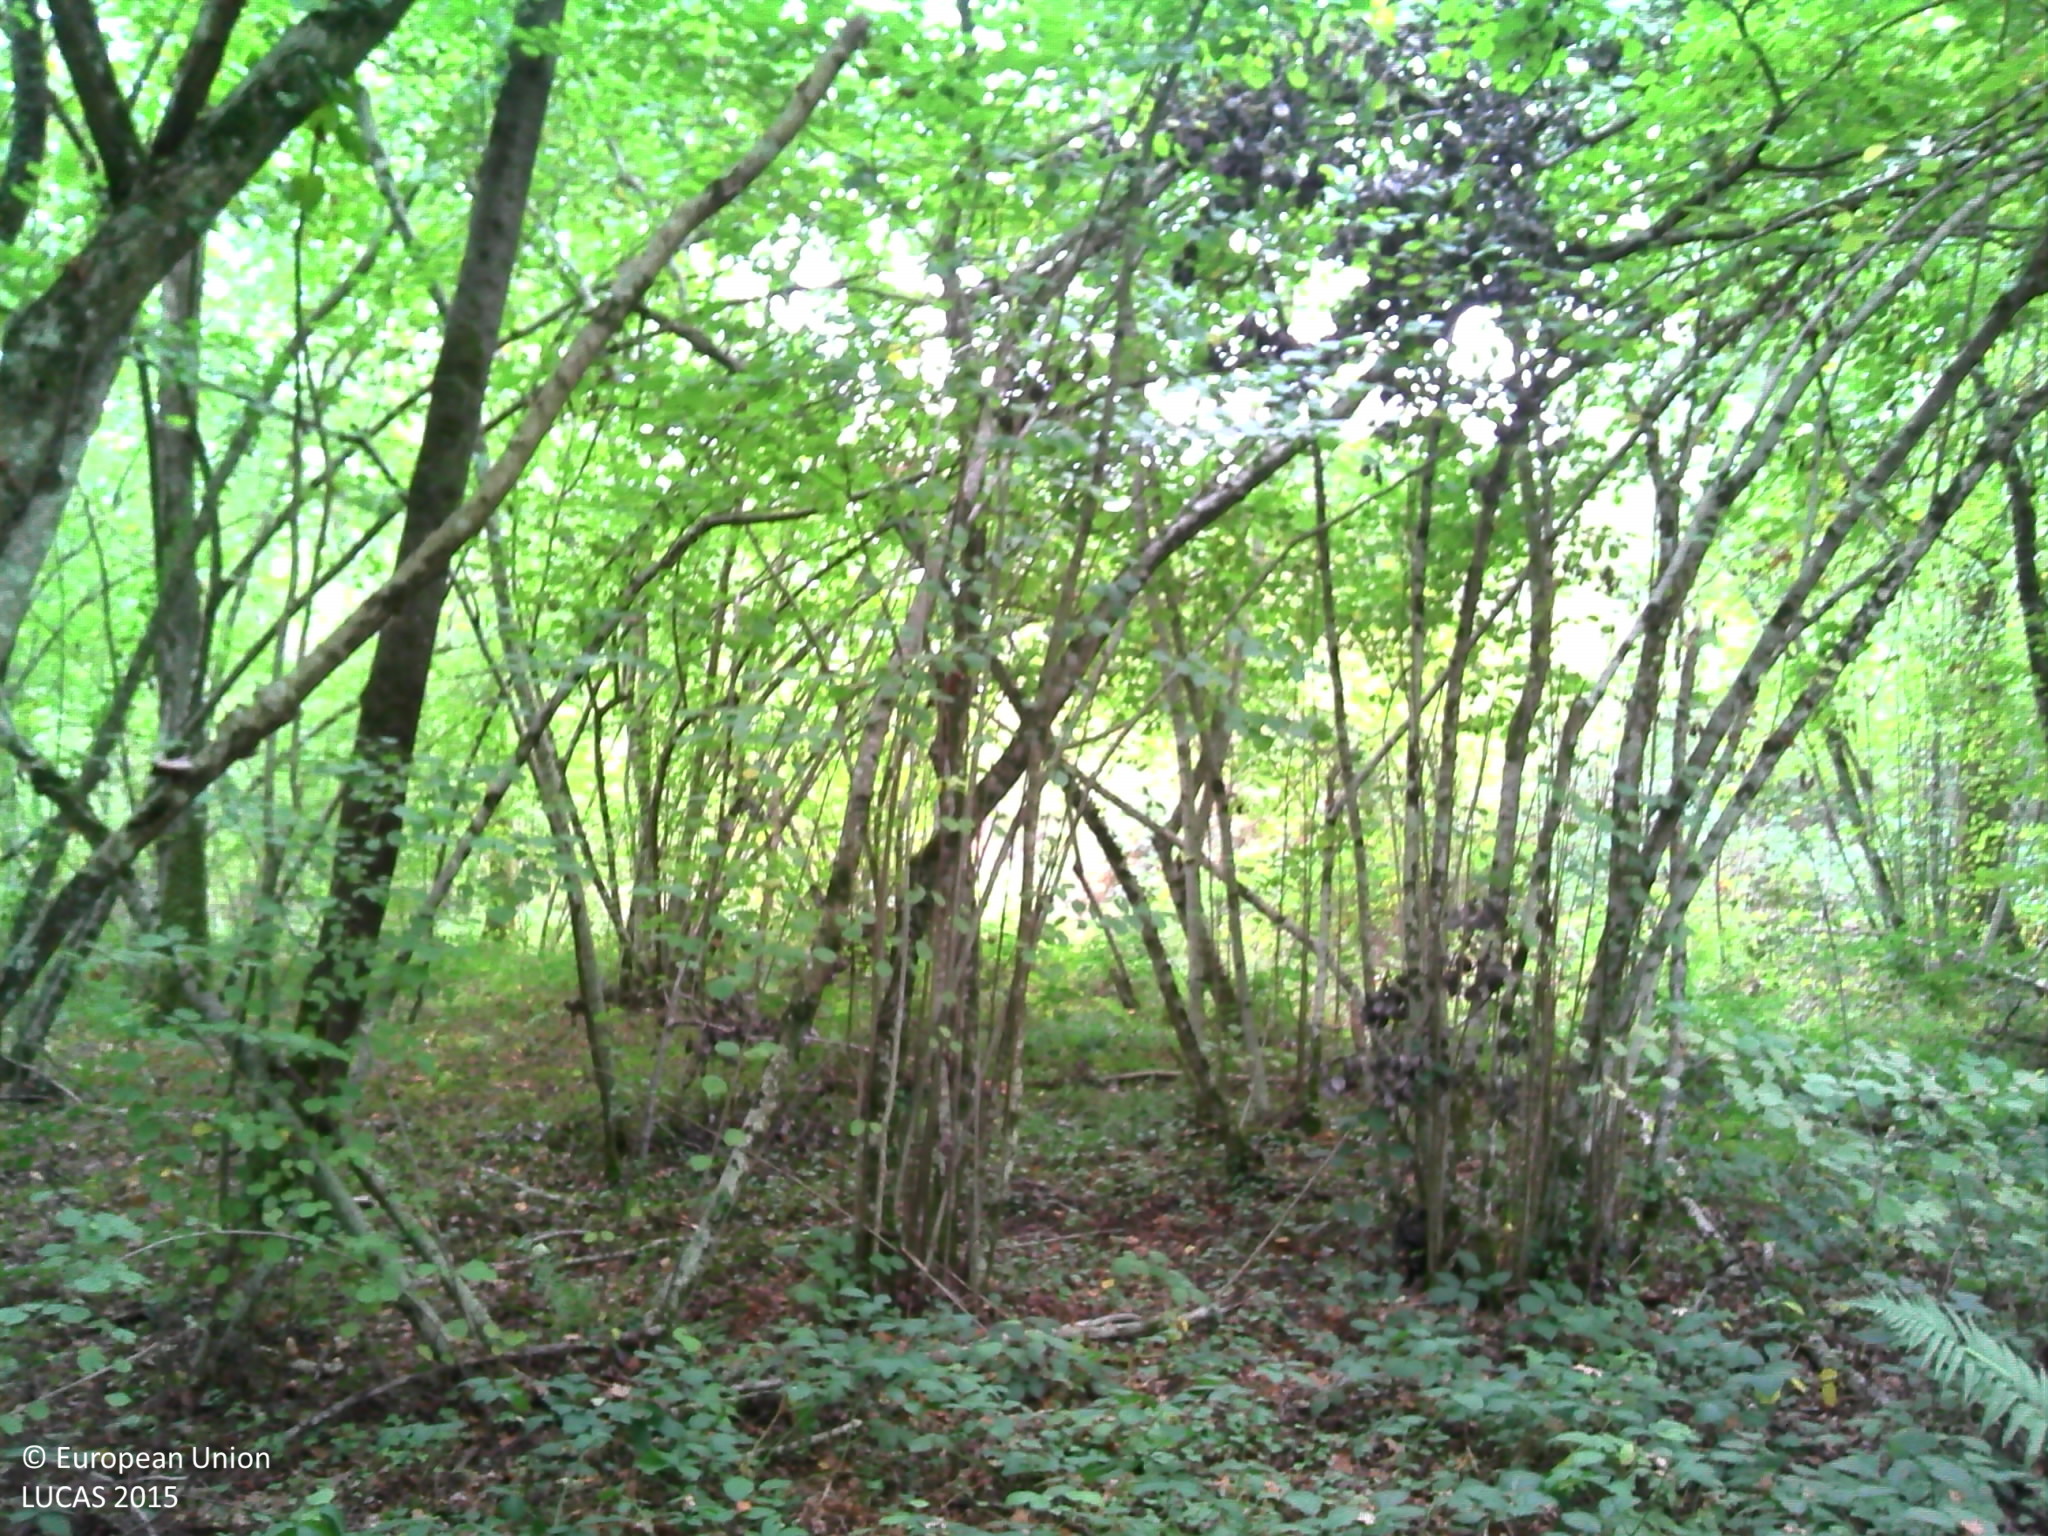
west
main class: Woodland
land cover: Broadleaved woodland
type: mesophytic deciduous forest
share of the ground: > 75 %
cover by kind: broadleaved forest trees 90 %, herbaceous plants 10 %
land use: Forestry
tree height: > 5 m
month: October
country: FR
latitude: 46.2755
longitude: 5.1104
